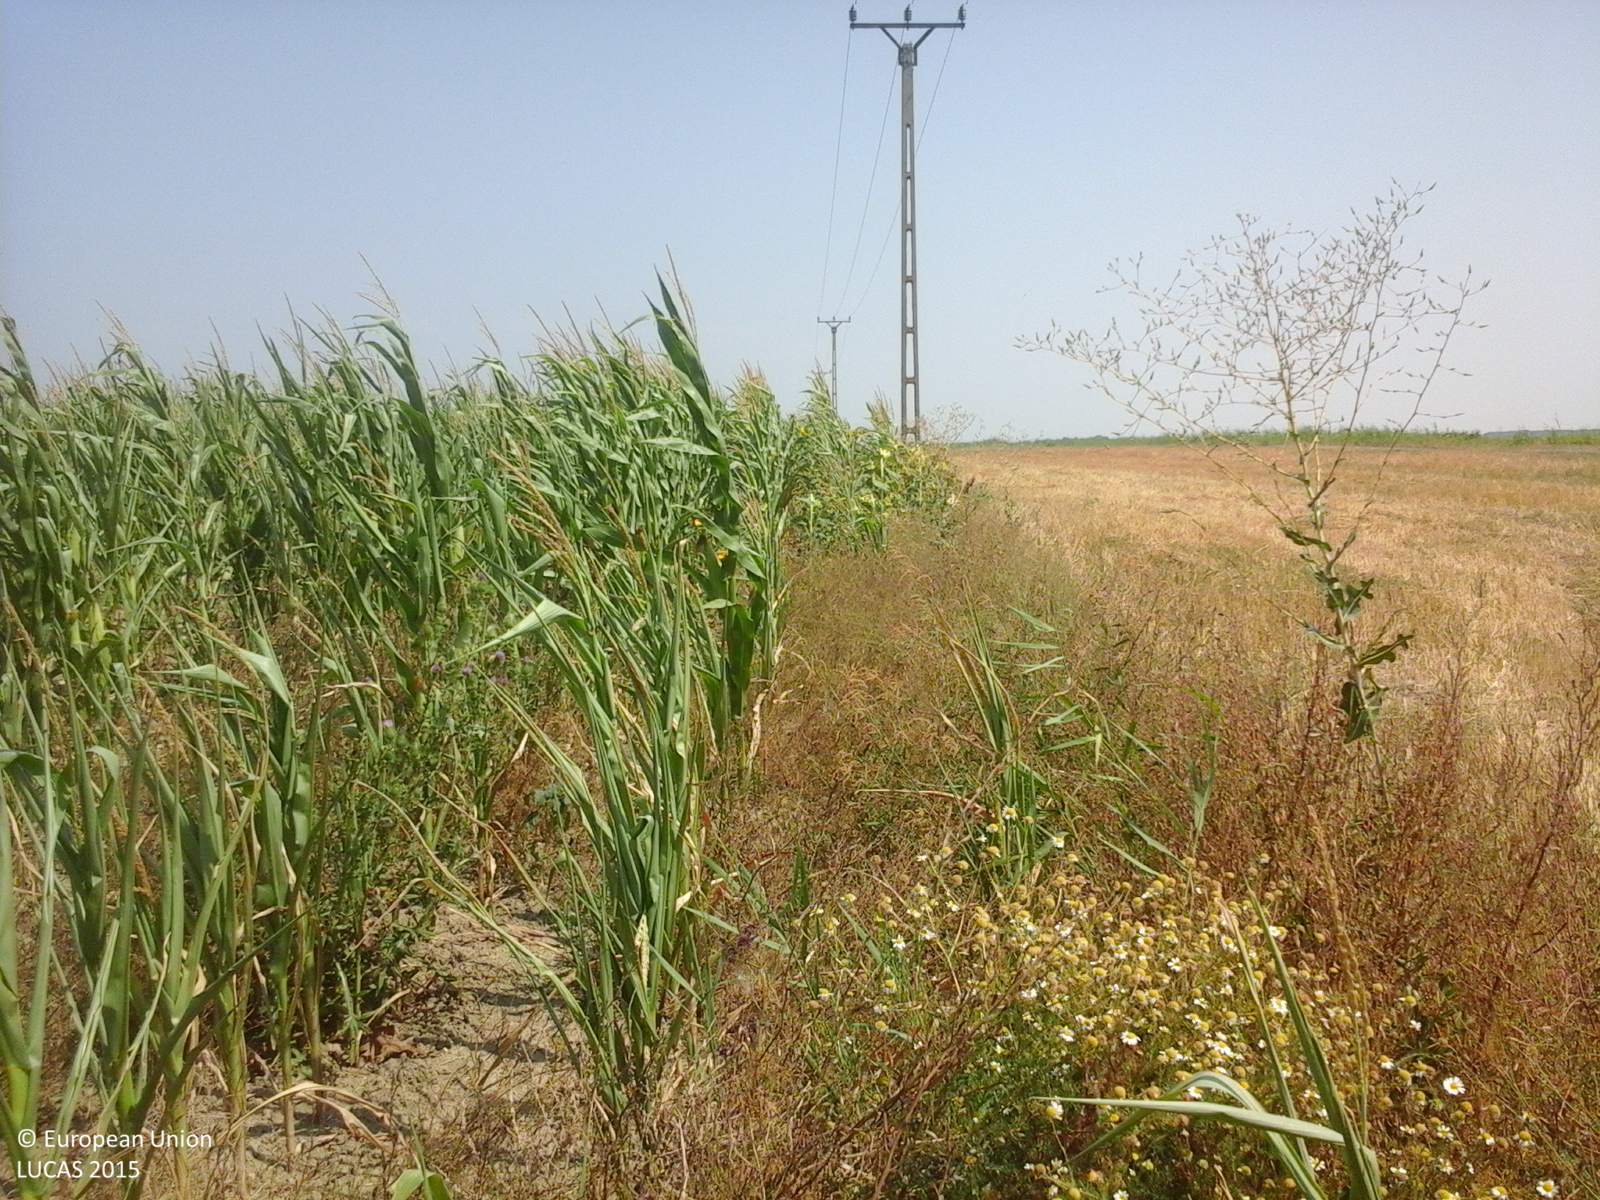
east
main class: Cropland
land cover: Maize
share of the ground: > 75 %
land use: Agriculture (excluding fallow land and kitchen gardens)
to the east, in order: Maize
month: July
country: RO
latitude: 45.4341
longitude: 27.7890
